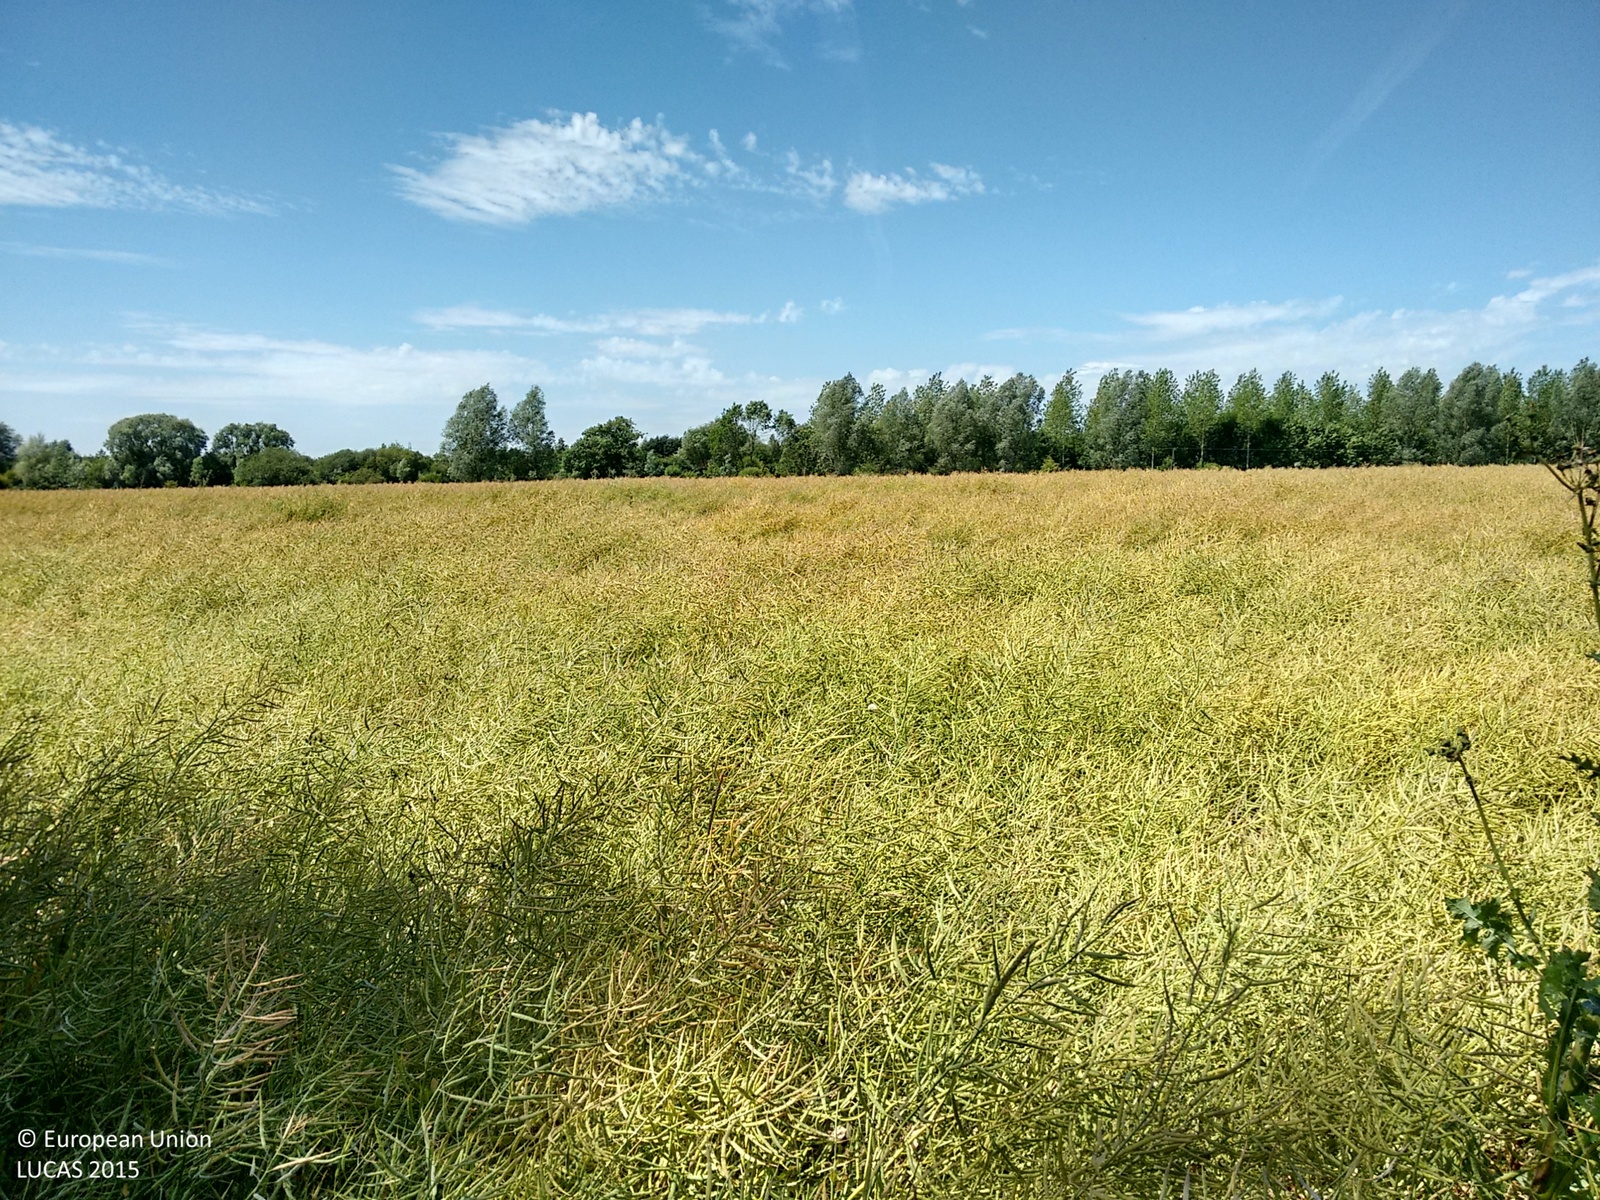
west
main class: Cropland
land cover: Rape and turnip rape
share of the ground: > 75 %
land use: Agriculture (excluding fallow land and kitchen gardens)
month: July
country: GB
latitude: 51.6796
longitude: -1.2270
